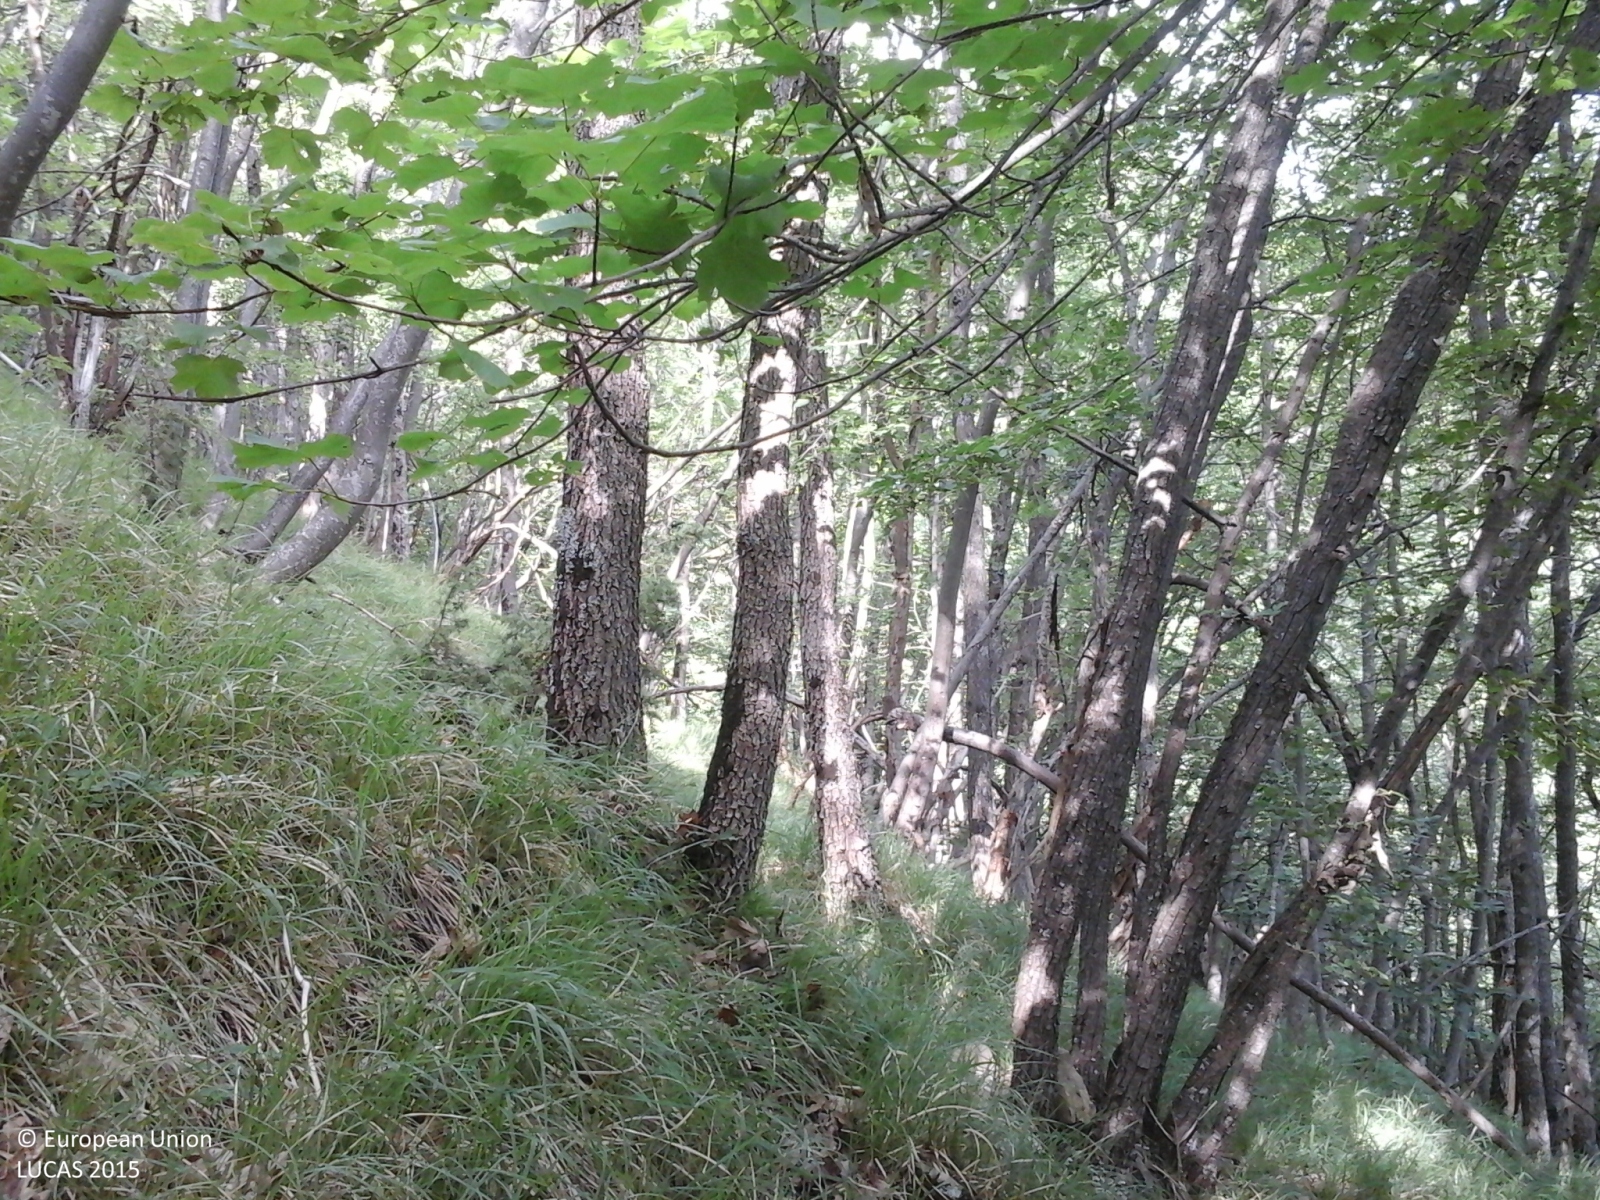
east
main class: Woodland
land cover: Broadleaved woodland
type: mesophytic deciduous forest
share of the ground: > 75 %
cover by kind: broadleaved forest trees 100 %
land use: Forestry
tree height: > 5 m
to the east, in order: Broadleaved woodland
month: June
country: IT
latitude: 44.6896
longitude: 9.1312
